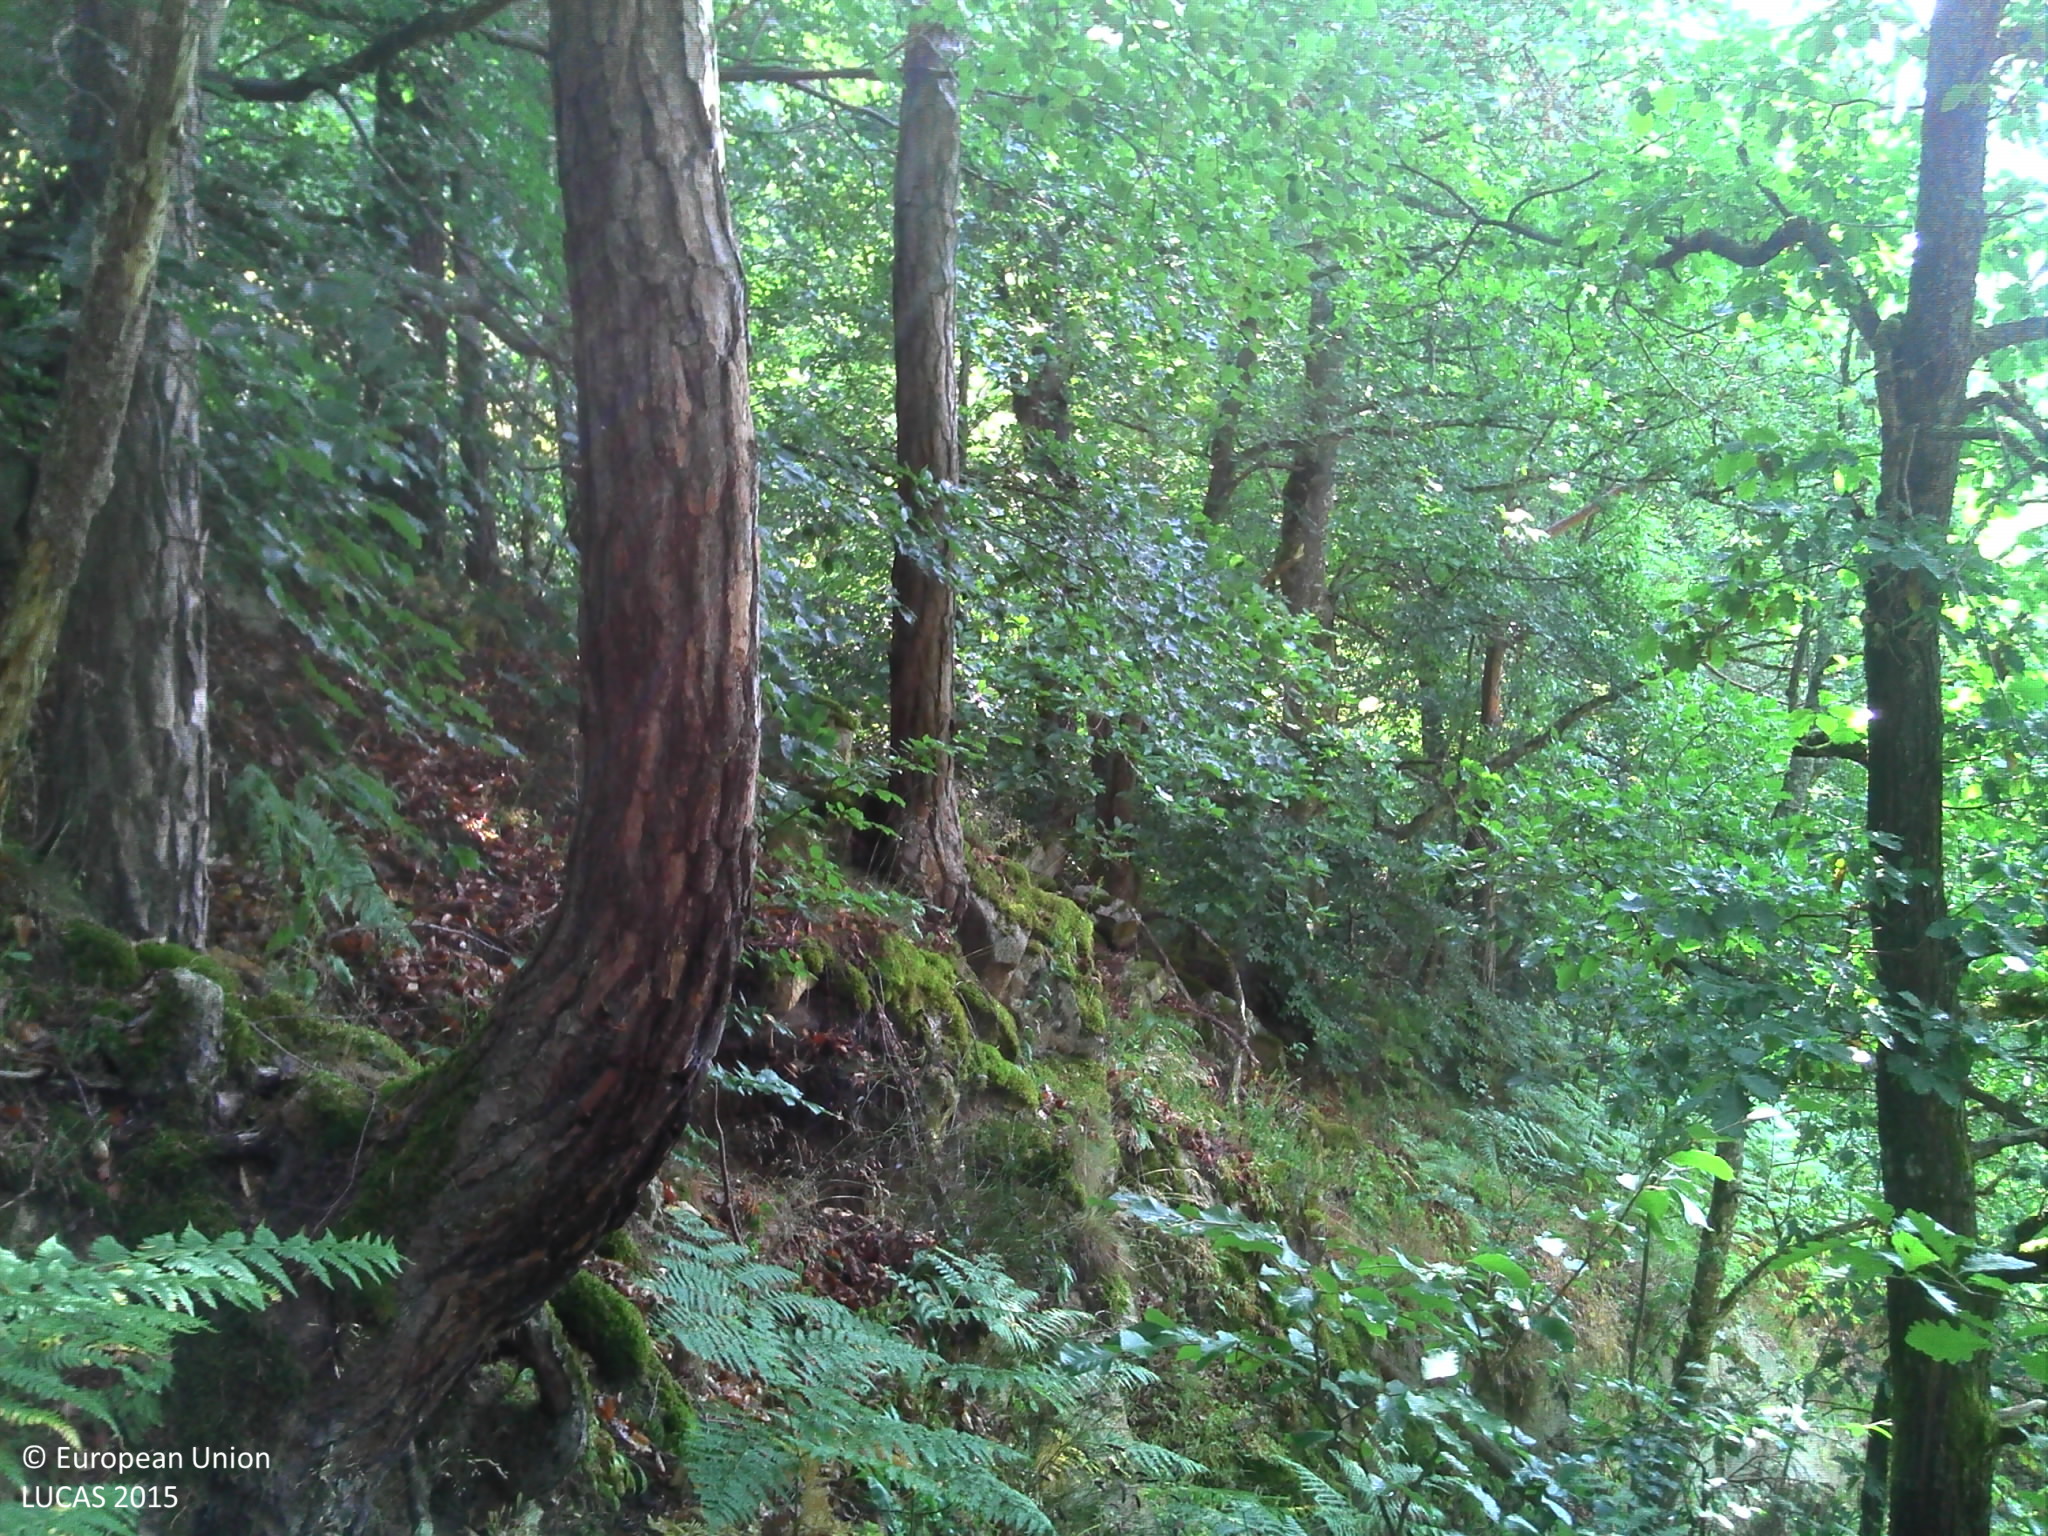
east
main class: Woodland
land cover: Pine dominated mixed woodland
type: mesophytic deciduous forest
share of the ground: > 75 %
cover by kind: broadleaved forest trees 65 %, coniferous forest trees 25 %, herbaceous plants 10 %
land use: Forestry
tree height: > 5 m
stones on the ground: < 10 %
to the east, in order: Pine dominated mixed woodland; Fences; Grass margins; Paved roads, cycling and walking lanes; Grass margins; Rock outcrops; Pine dominated mixed woodland
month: July
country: FR
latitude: 45.1624
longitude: 4.1649
